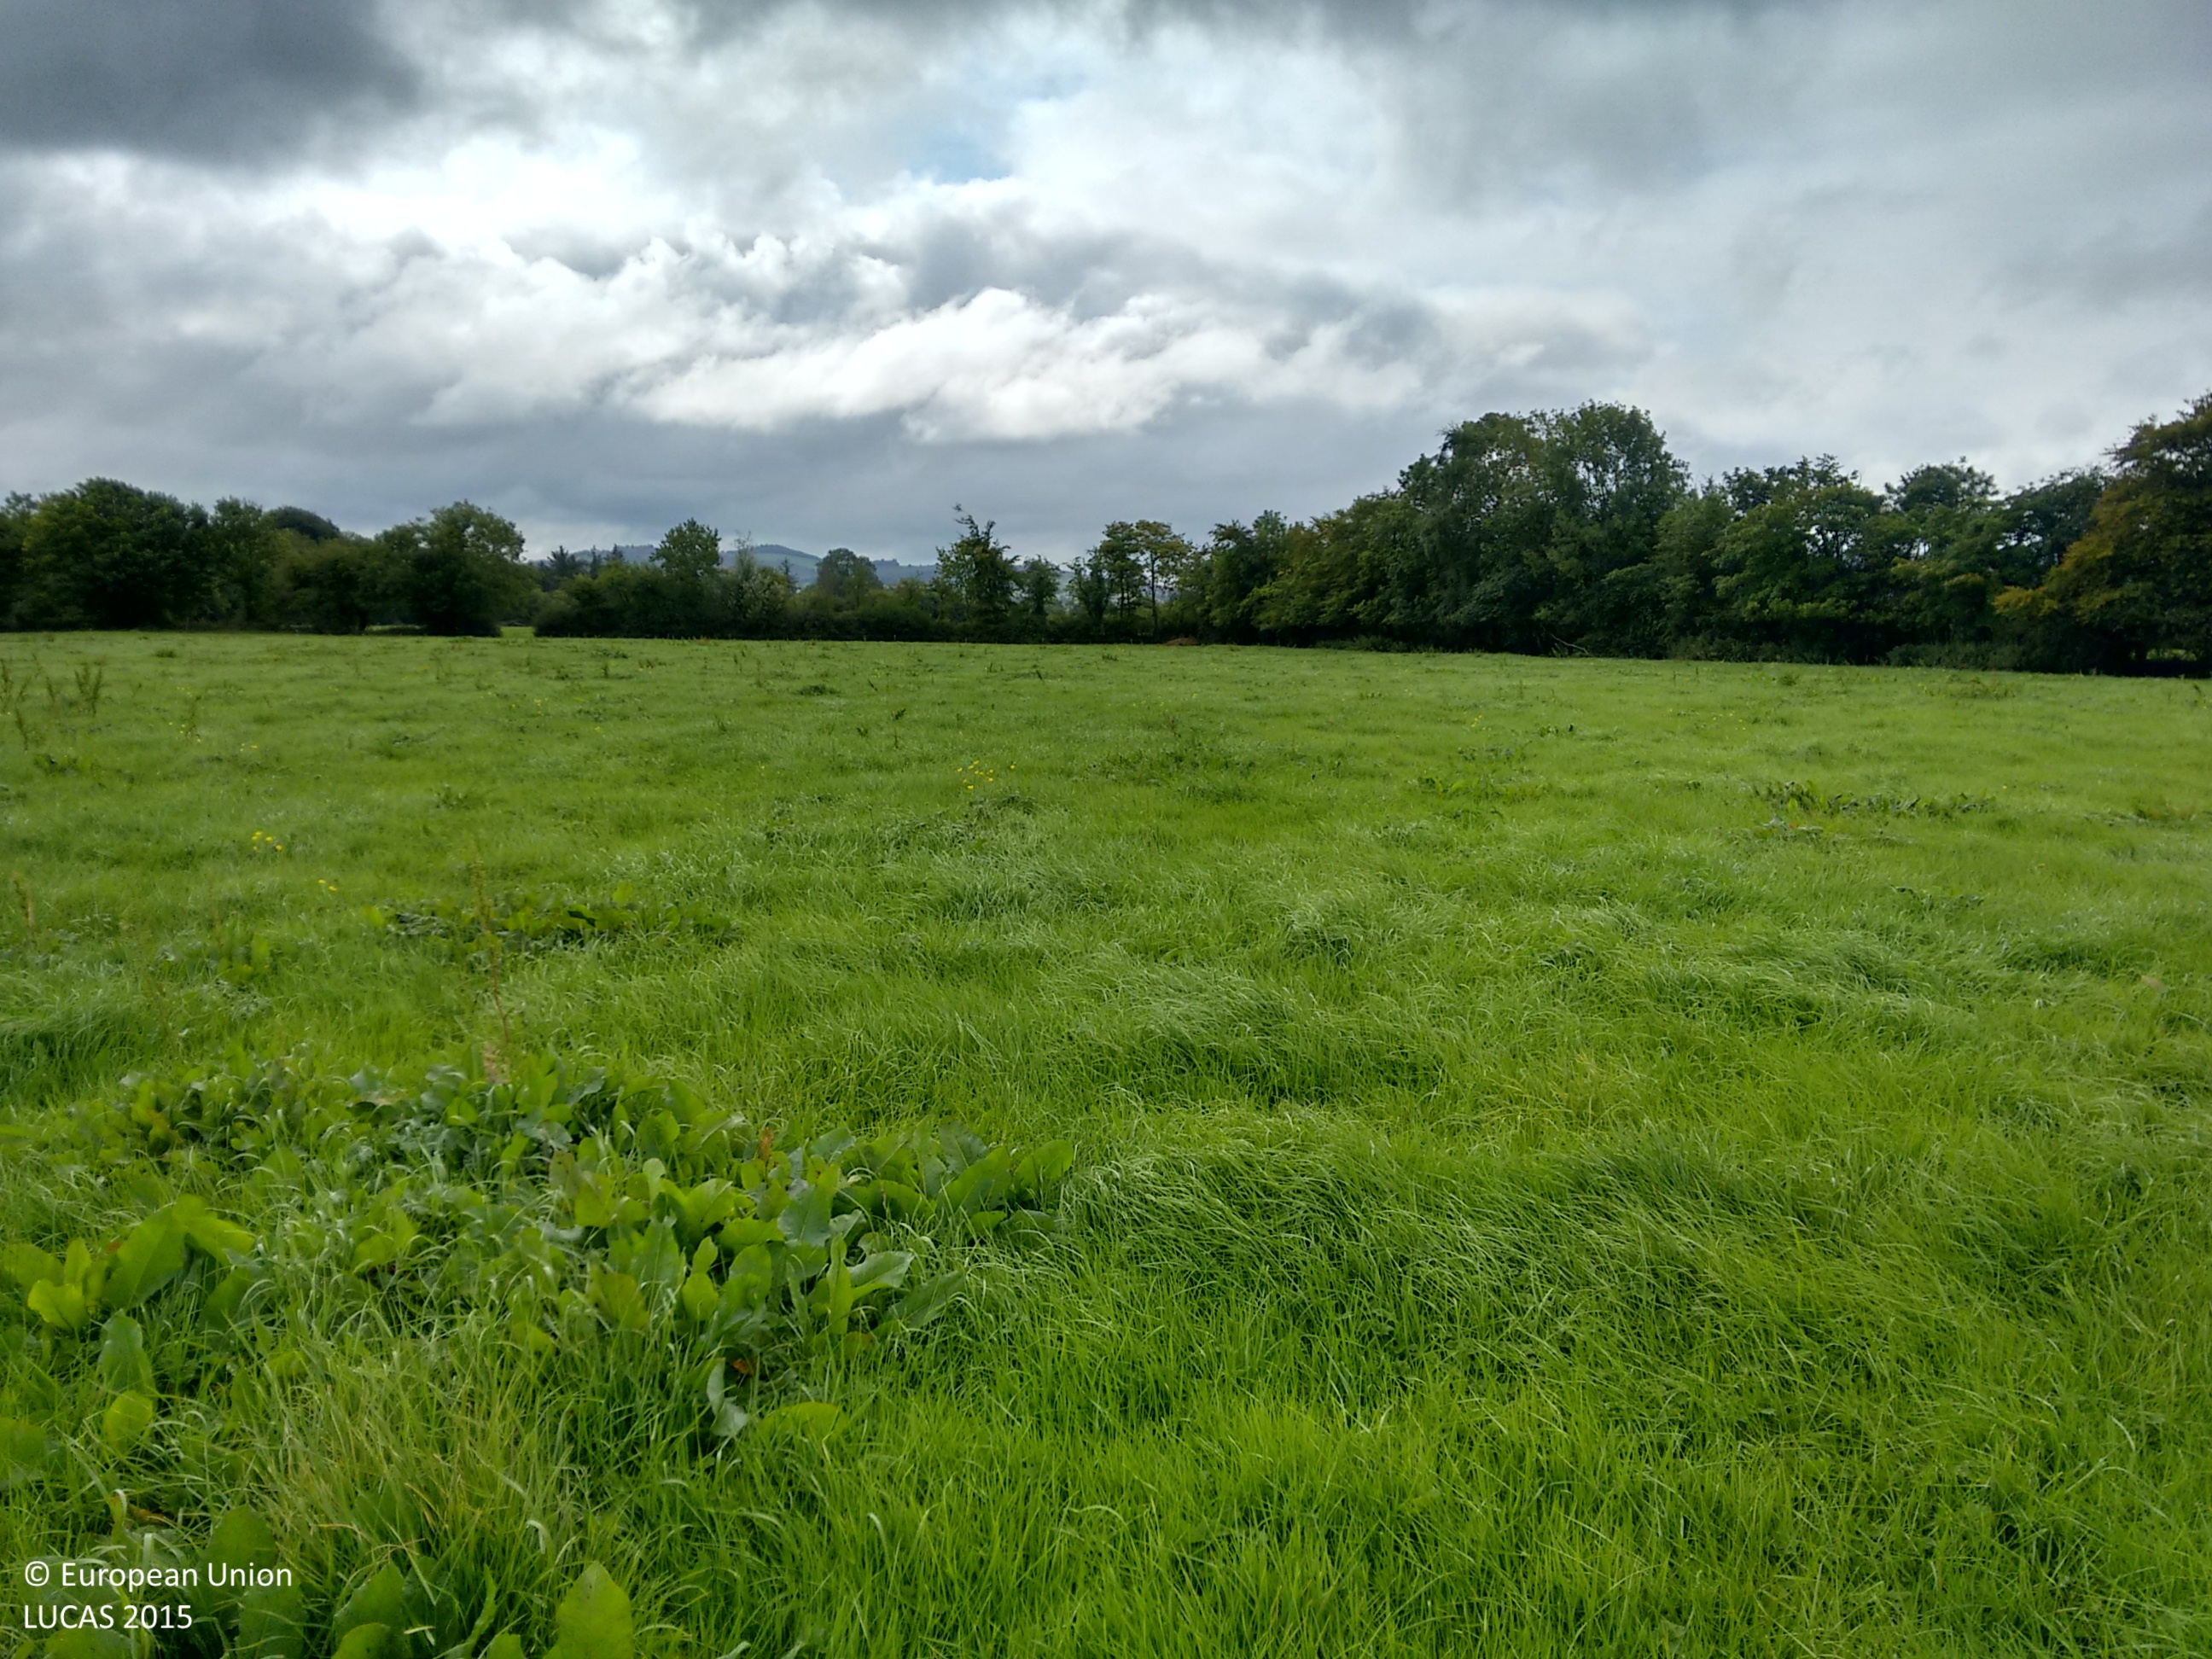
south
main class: Grassland
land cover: Grassland without tree/shrub cover
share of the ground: > 75 %
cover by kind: herbaceous plants 100 %
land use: Agriculture (excluding fallow land and kitchen gardens)
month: September
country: IE
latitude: 52.3847
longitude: -8.4854
